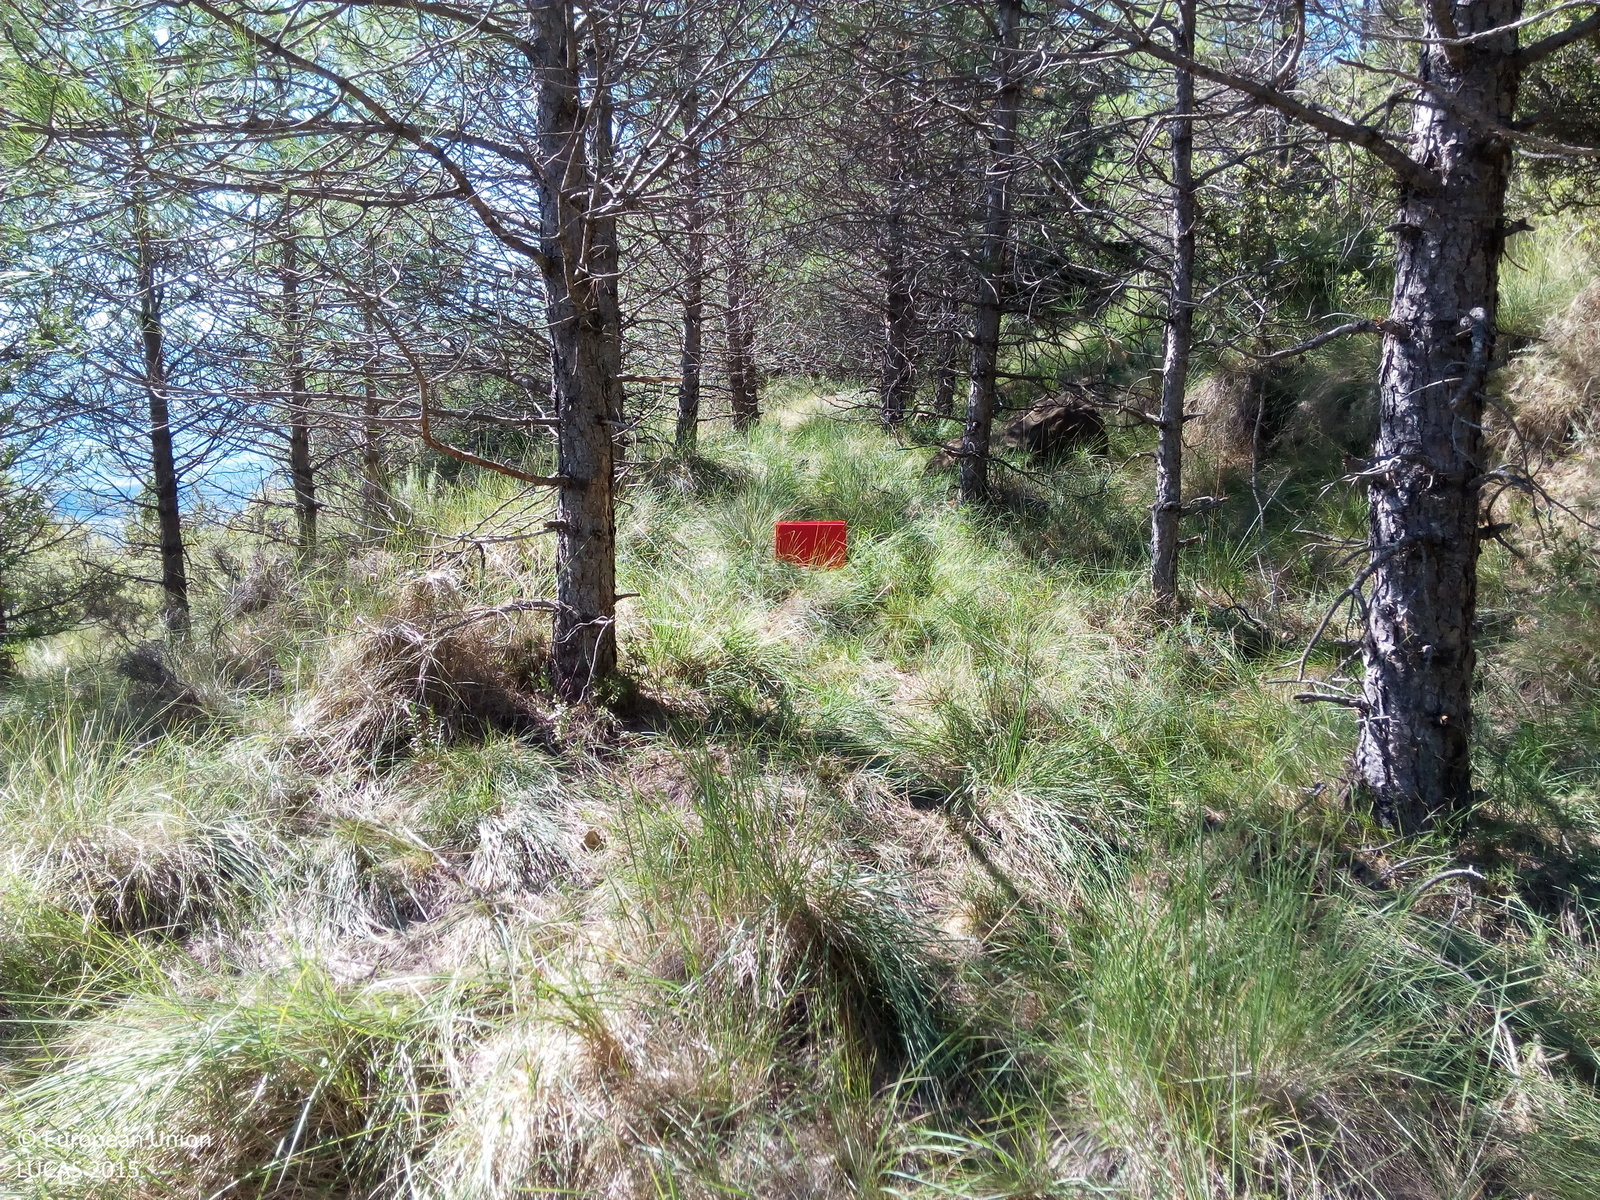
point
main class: Woodland
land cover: Pine dominated coniferous woodland
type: alpine coniferous forest
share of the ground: > 75 %
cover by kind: coniferous forest trees 80 %, shrubs 20 %
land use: Forestry
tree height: > 5 m
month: August
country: ES
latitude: 42.4316
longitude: 0.1940
